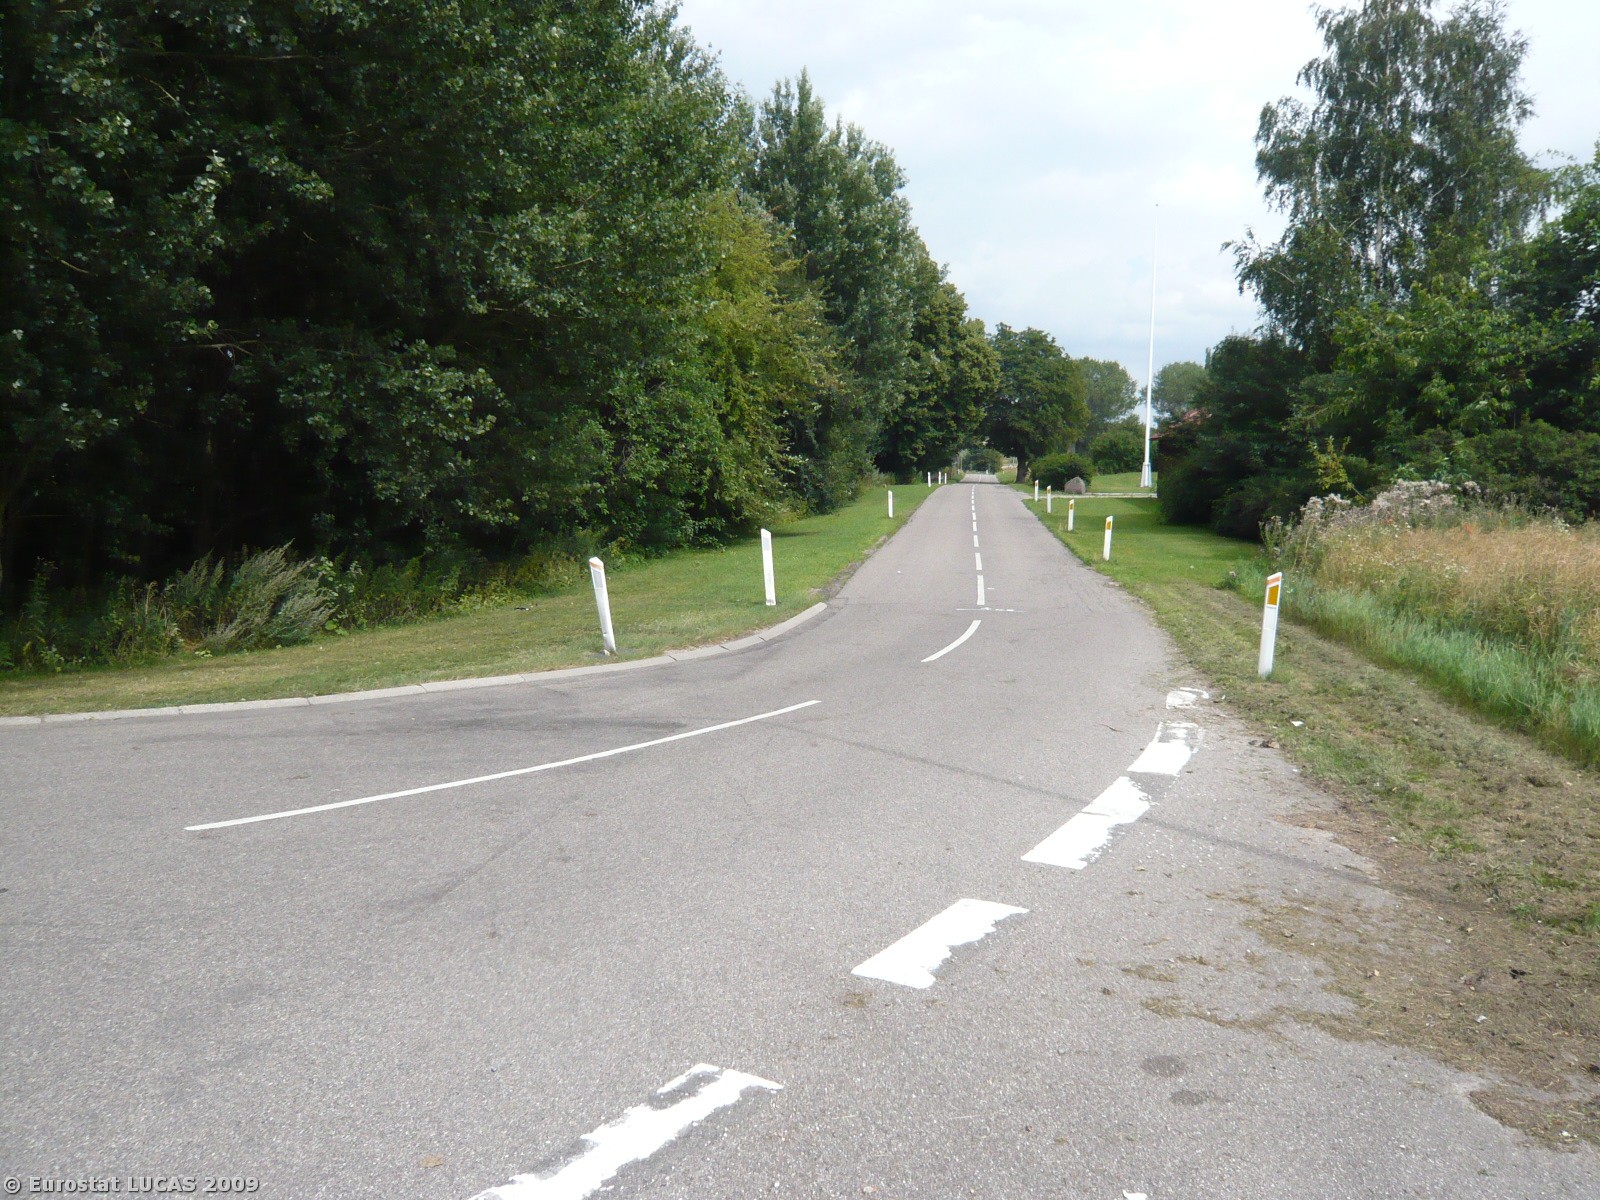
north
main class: Grassland
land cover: Grassland without tree/shrub cover
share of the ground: > 75 %
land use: Residential
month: July
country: DK
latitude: 55.8291
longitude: 12.0894
